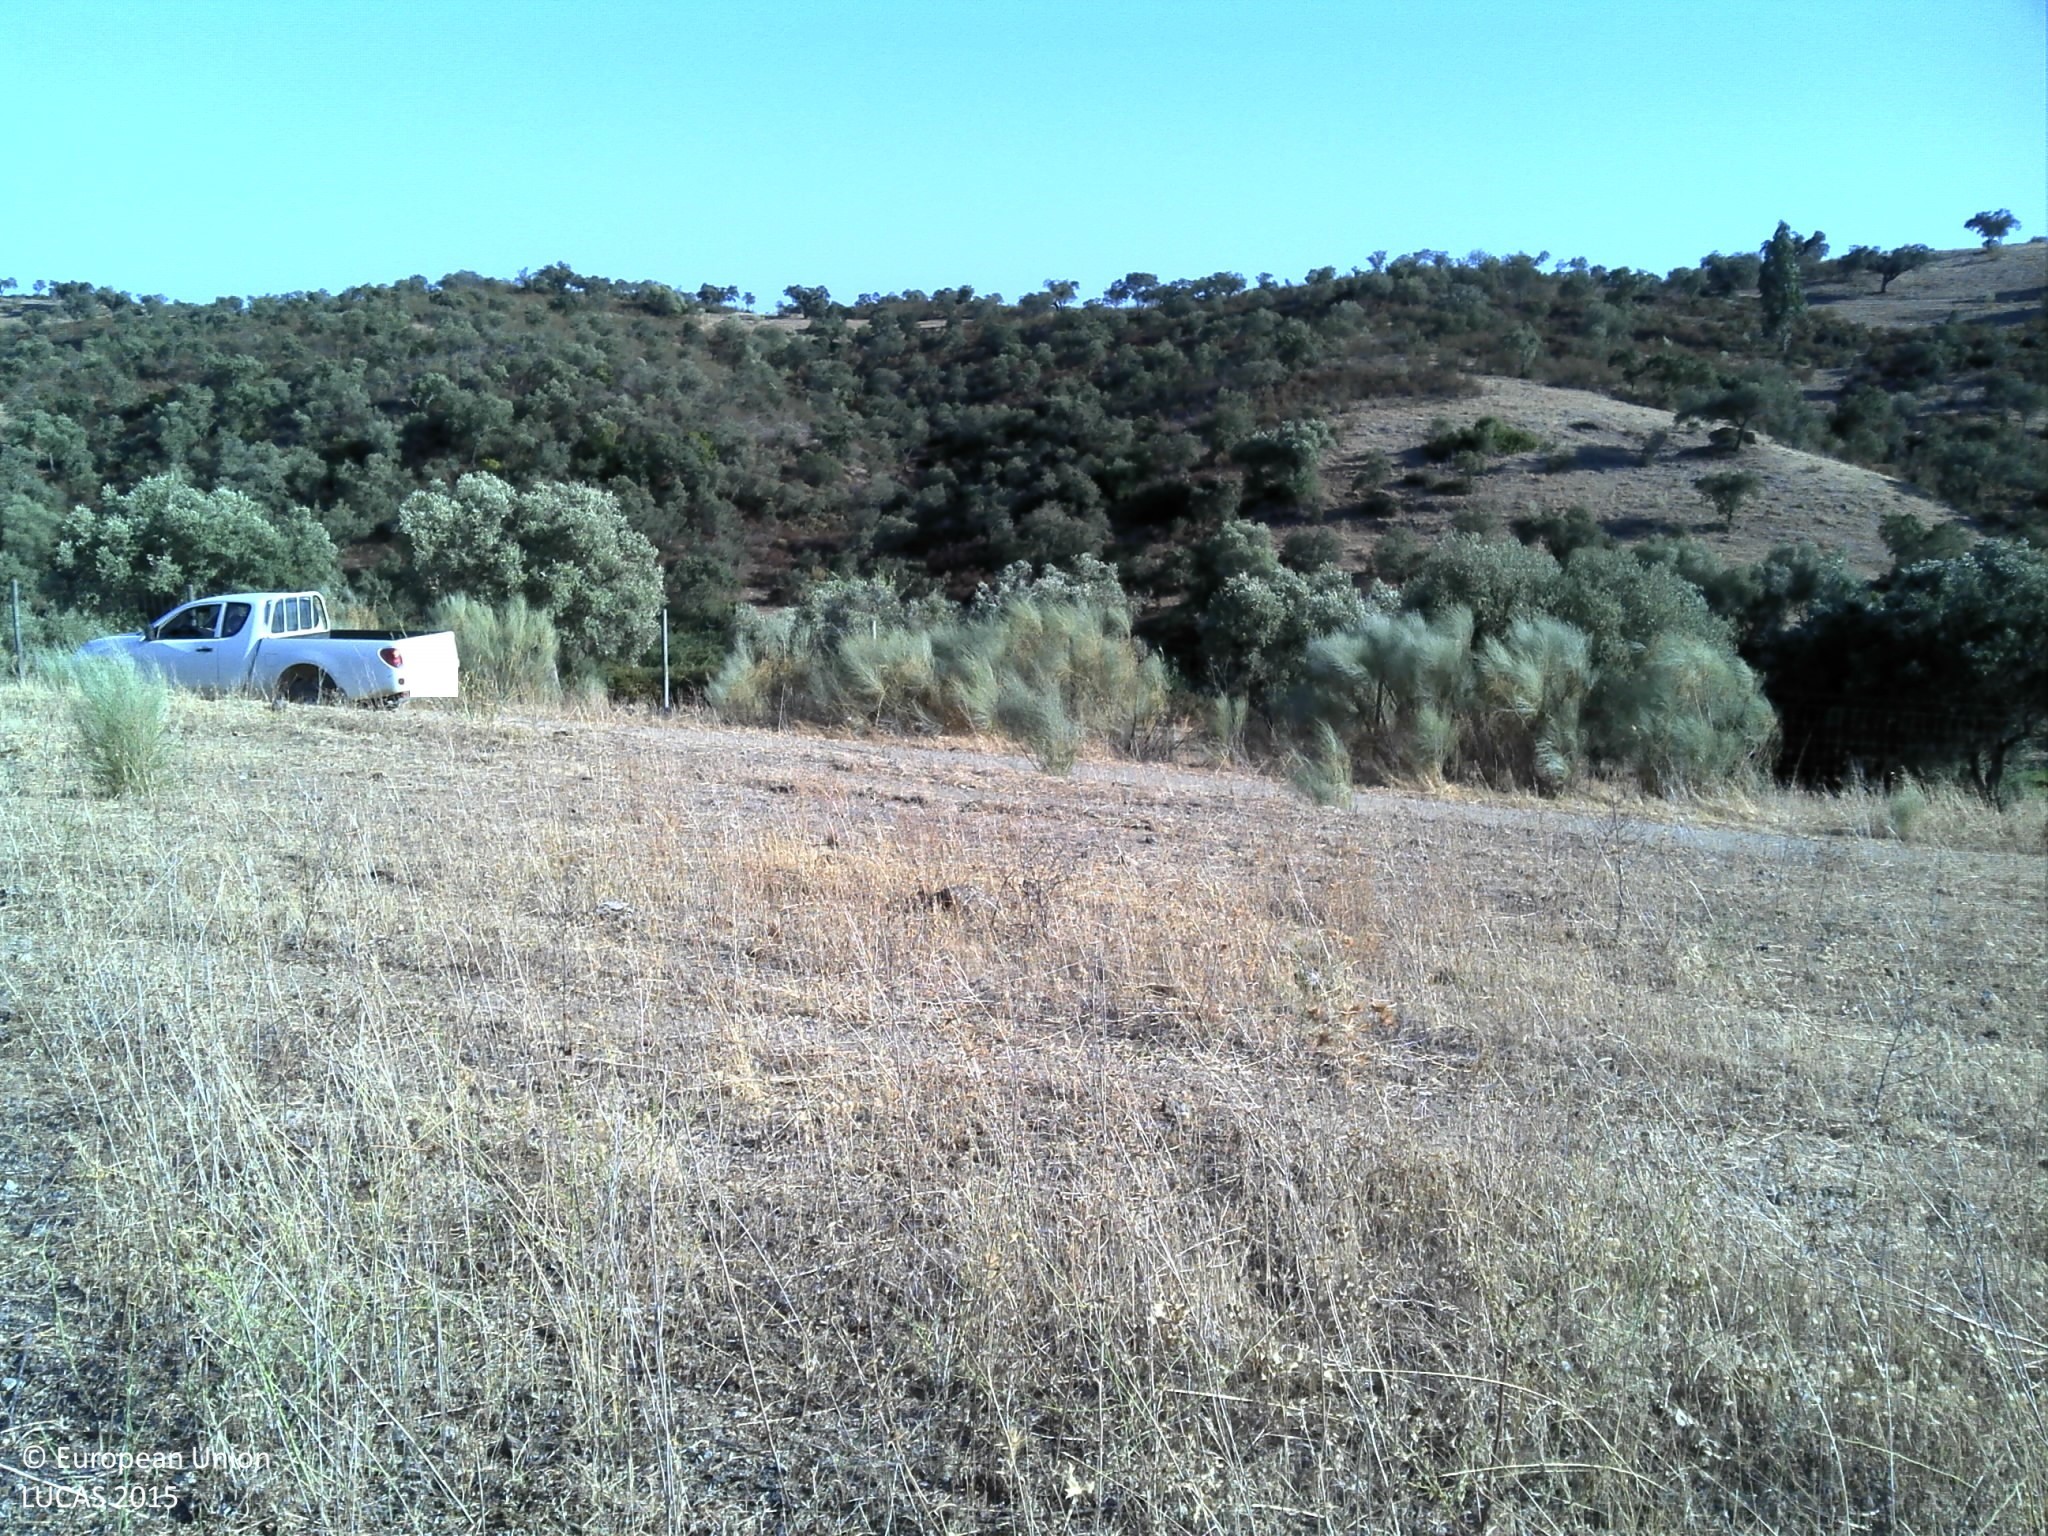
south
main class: Grassland
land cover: Grassland with sparse tree/shrub cover
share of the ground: 25 - 50 %
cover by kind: herbaceous plants 90 %, broadleaved forest trees 5 %, unconsolidated bare surface 5 %
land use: Agriculture (excluding fallow land and kitchen gardens)
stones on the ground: < 10 %
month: July
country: PT
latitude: 37.9113
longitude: -7.6625
